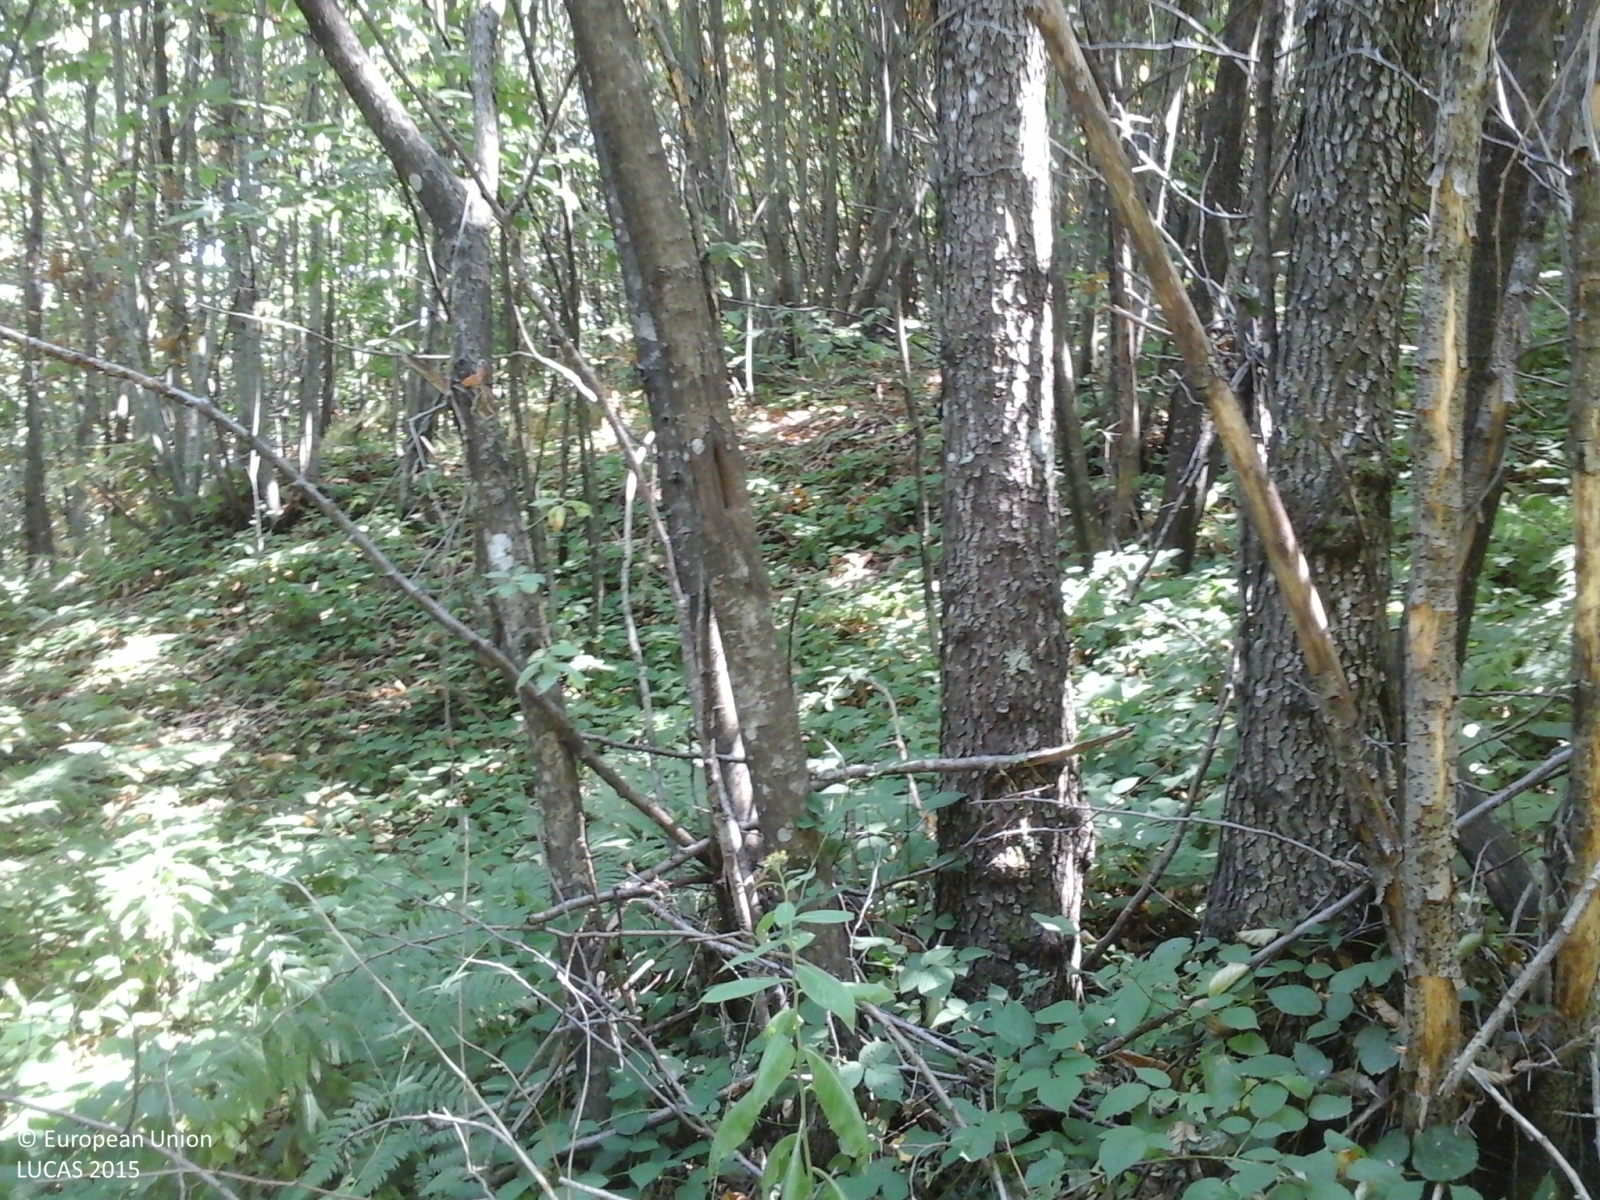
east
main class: Woodland
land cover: Broadleaved woodland
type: thermophilous deciduous forest
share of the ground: > 75 %
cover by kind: broadleaved forest trees 95 %, shrubs 5 %
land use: Forestry
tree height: > 5 m
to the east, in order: Broadleaved woodland; Ditches and canals; Broadleaved woodland; Grass margins; Paved roads, cycling and walking lanes; Grass margins; Broadleaved woodland; Grass margins; Paved roads, cycling and walking lanes
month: August
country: IT
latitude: 44.0050
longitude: 10.7589
